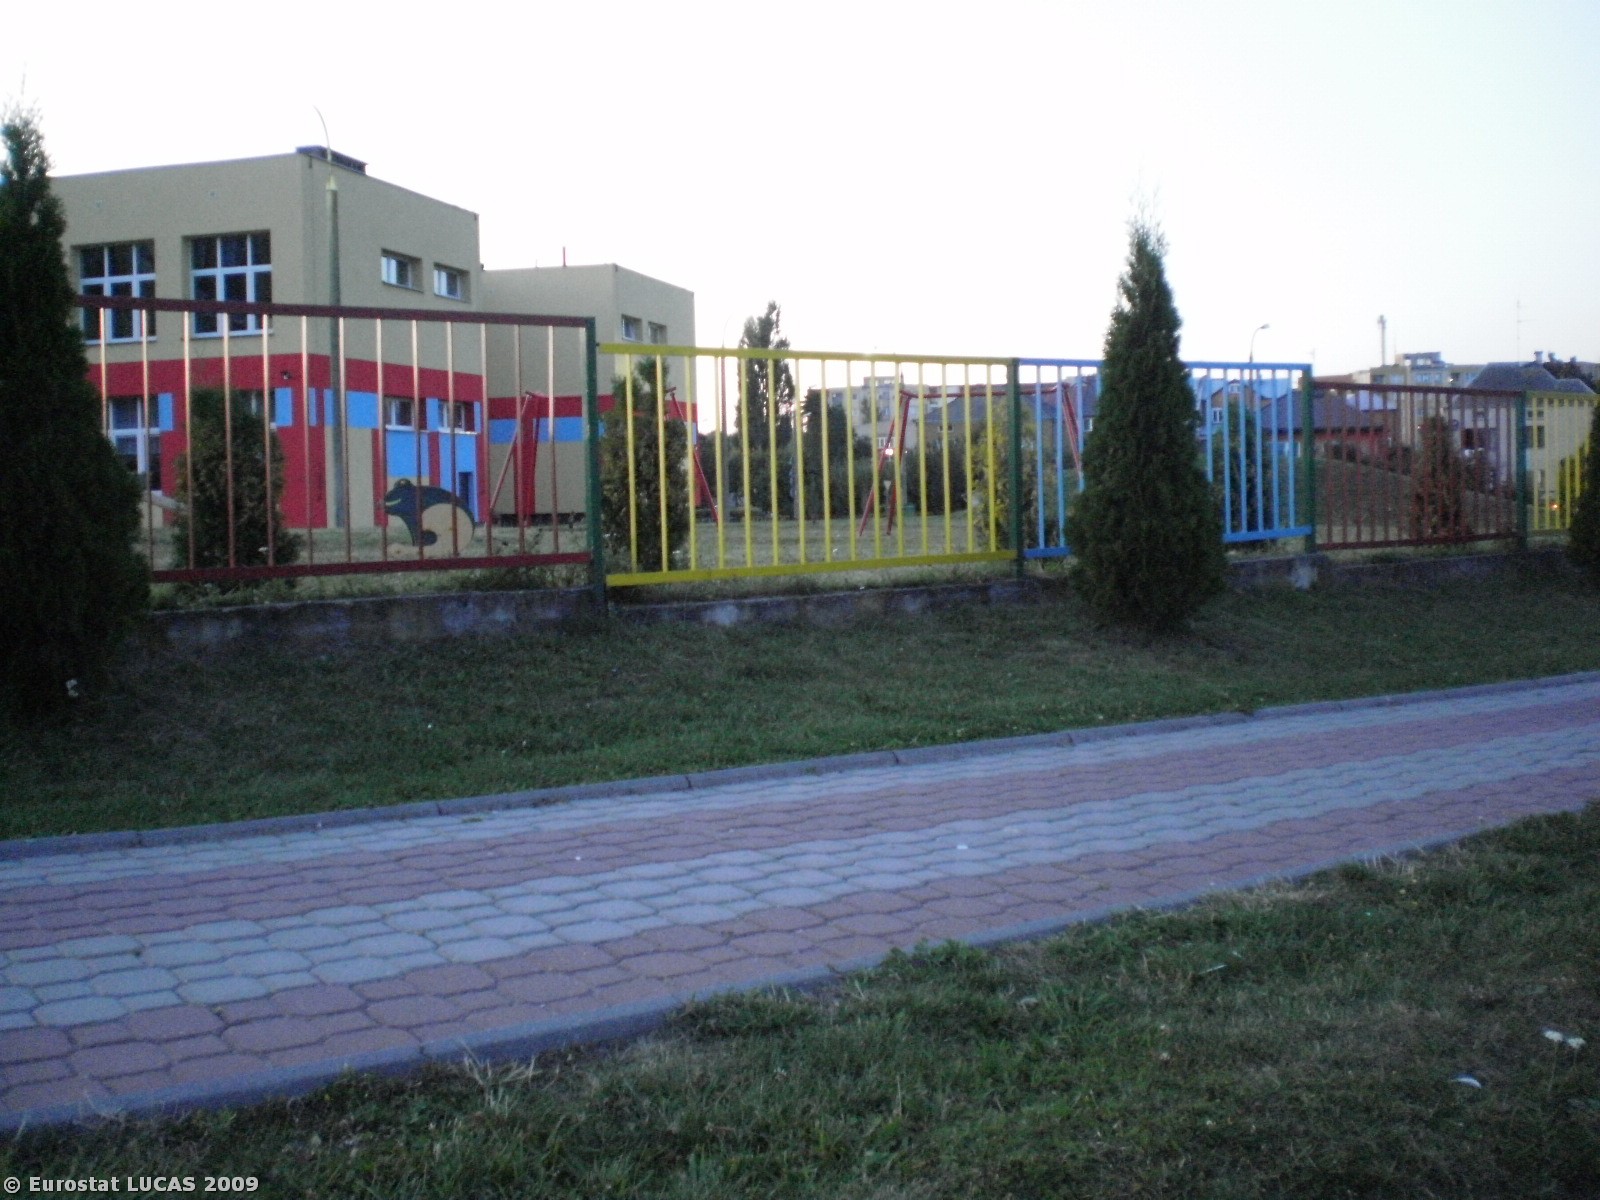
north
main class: Grassland
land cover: Grassland with sparse tree/shrub cover
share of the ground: > 75 %
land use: Commerce, finance, business
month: August
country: PL
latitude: 53.4101
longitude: 21.9258
